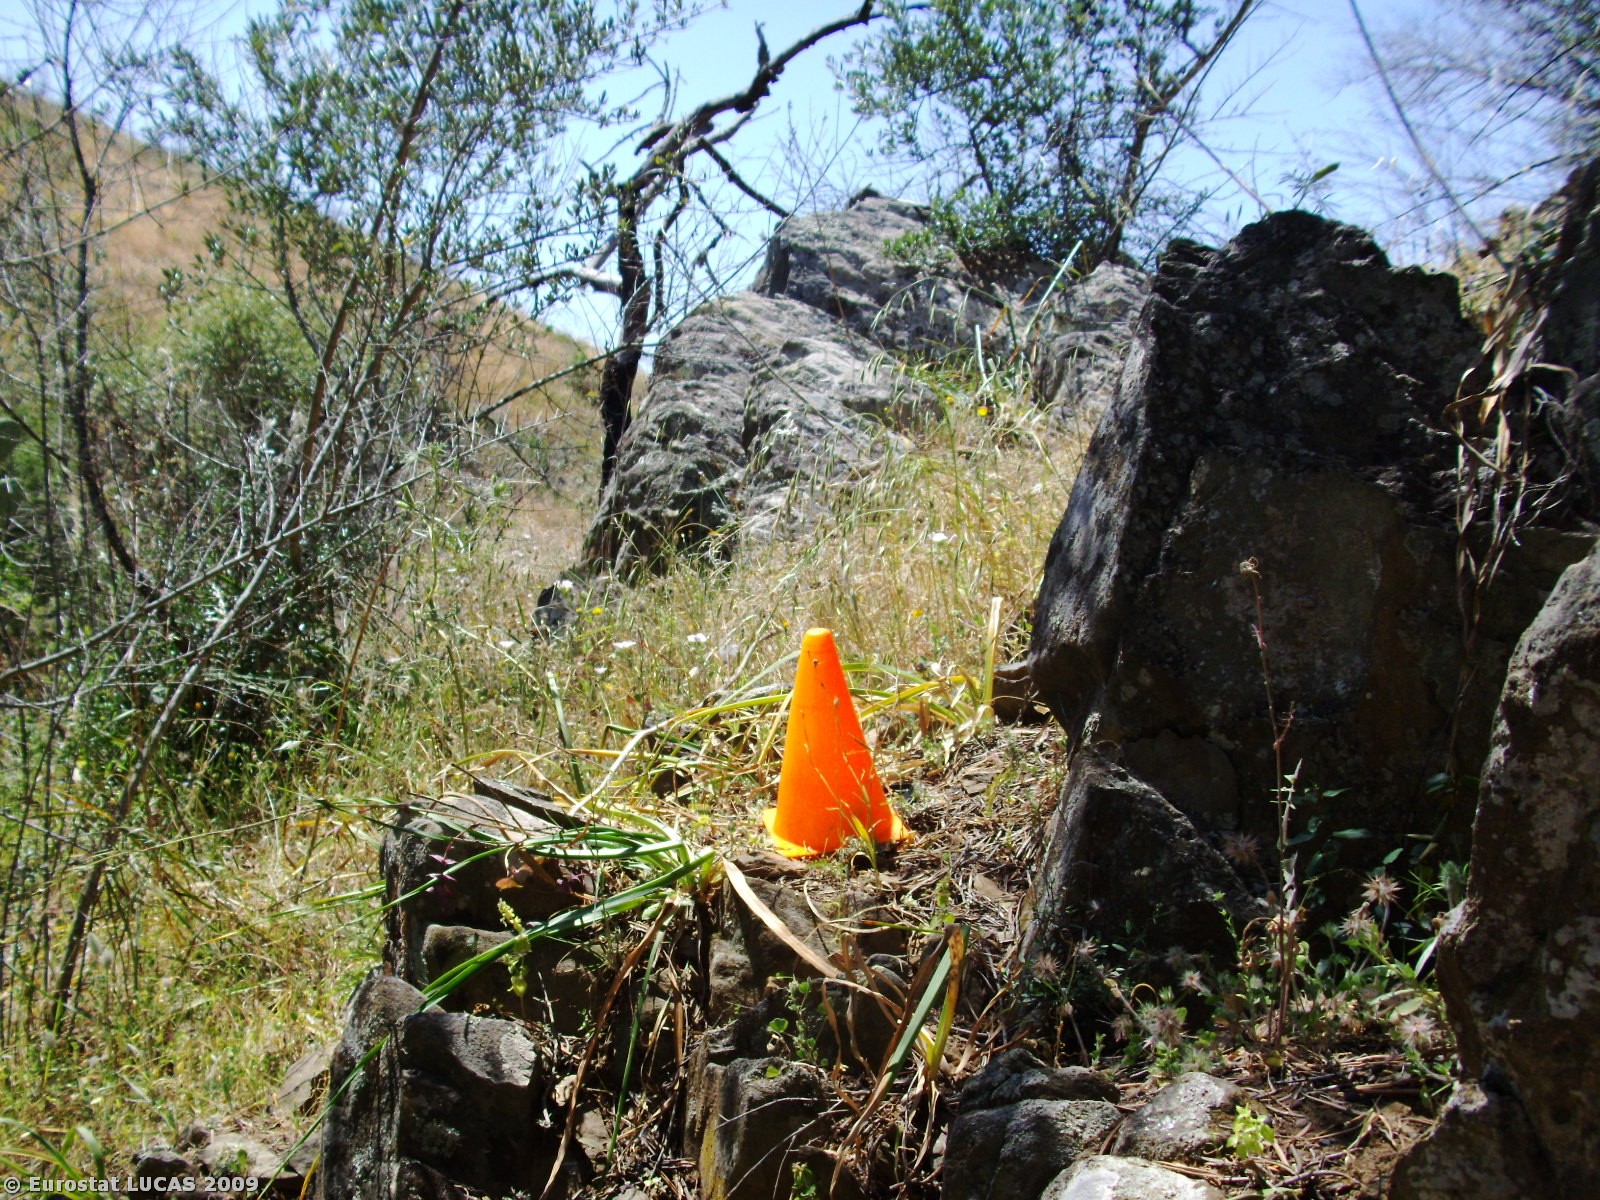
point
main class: Cropland
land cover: Olive groves
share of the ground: 25 - 50 %
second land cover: Spontaneously vegetated surfaces
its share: > 75 %
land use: Fallow land
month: May
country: PT
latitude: 37.5155
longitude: -7.6049
